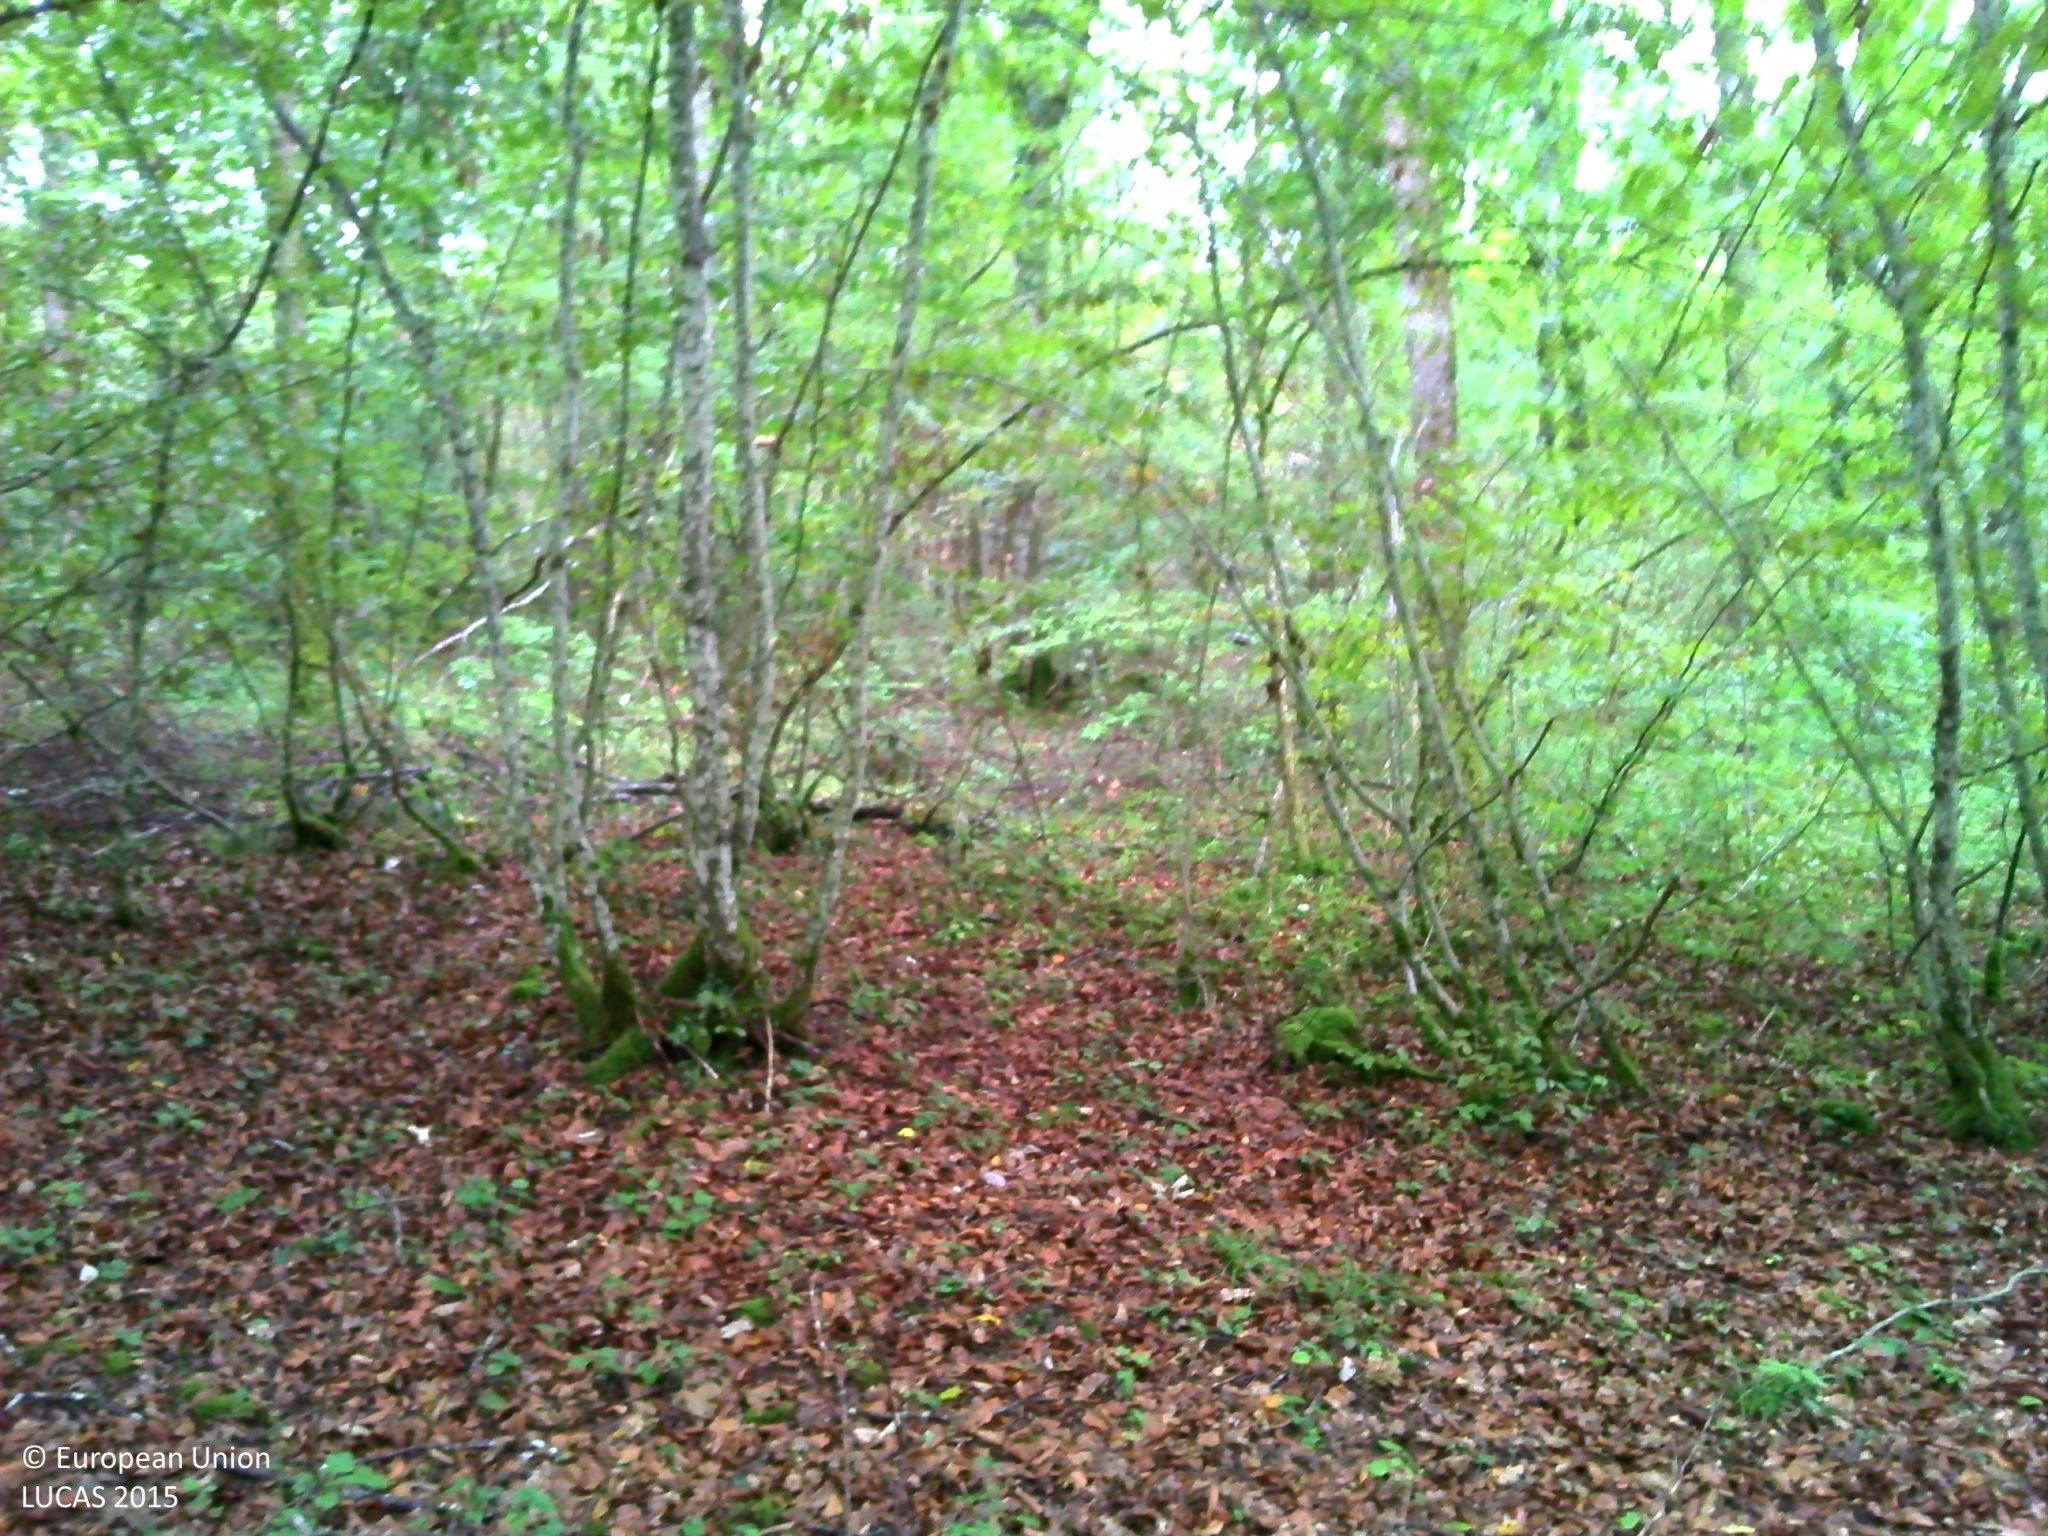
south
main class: Woodland
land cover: Broadleaved woodland
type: mesophytic deciduous forest
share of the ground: > 75 %
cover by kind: broadleaved forest trees 80 %, herbaceous plants 15 %, shrubs 5 %
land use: Forestry
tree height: > 5 m
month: September
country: FR
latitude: 47.1266
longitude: 4.7935
